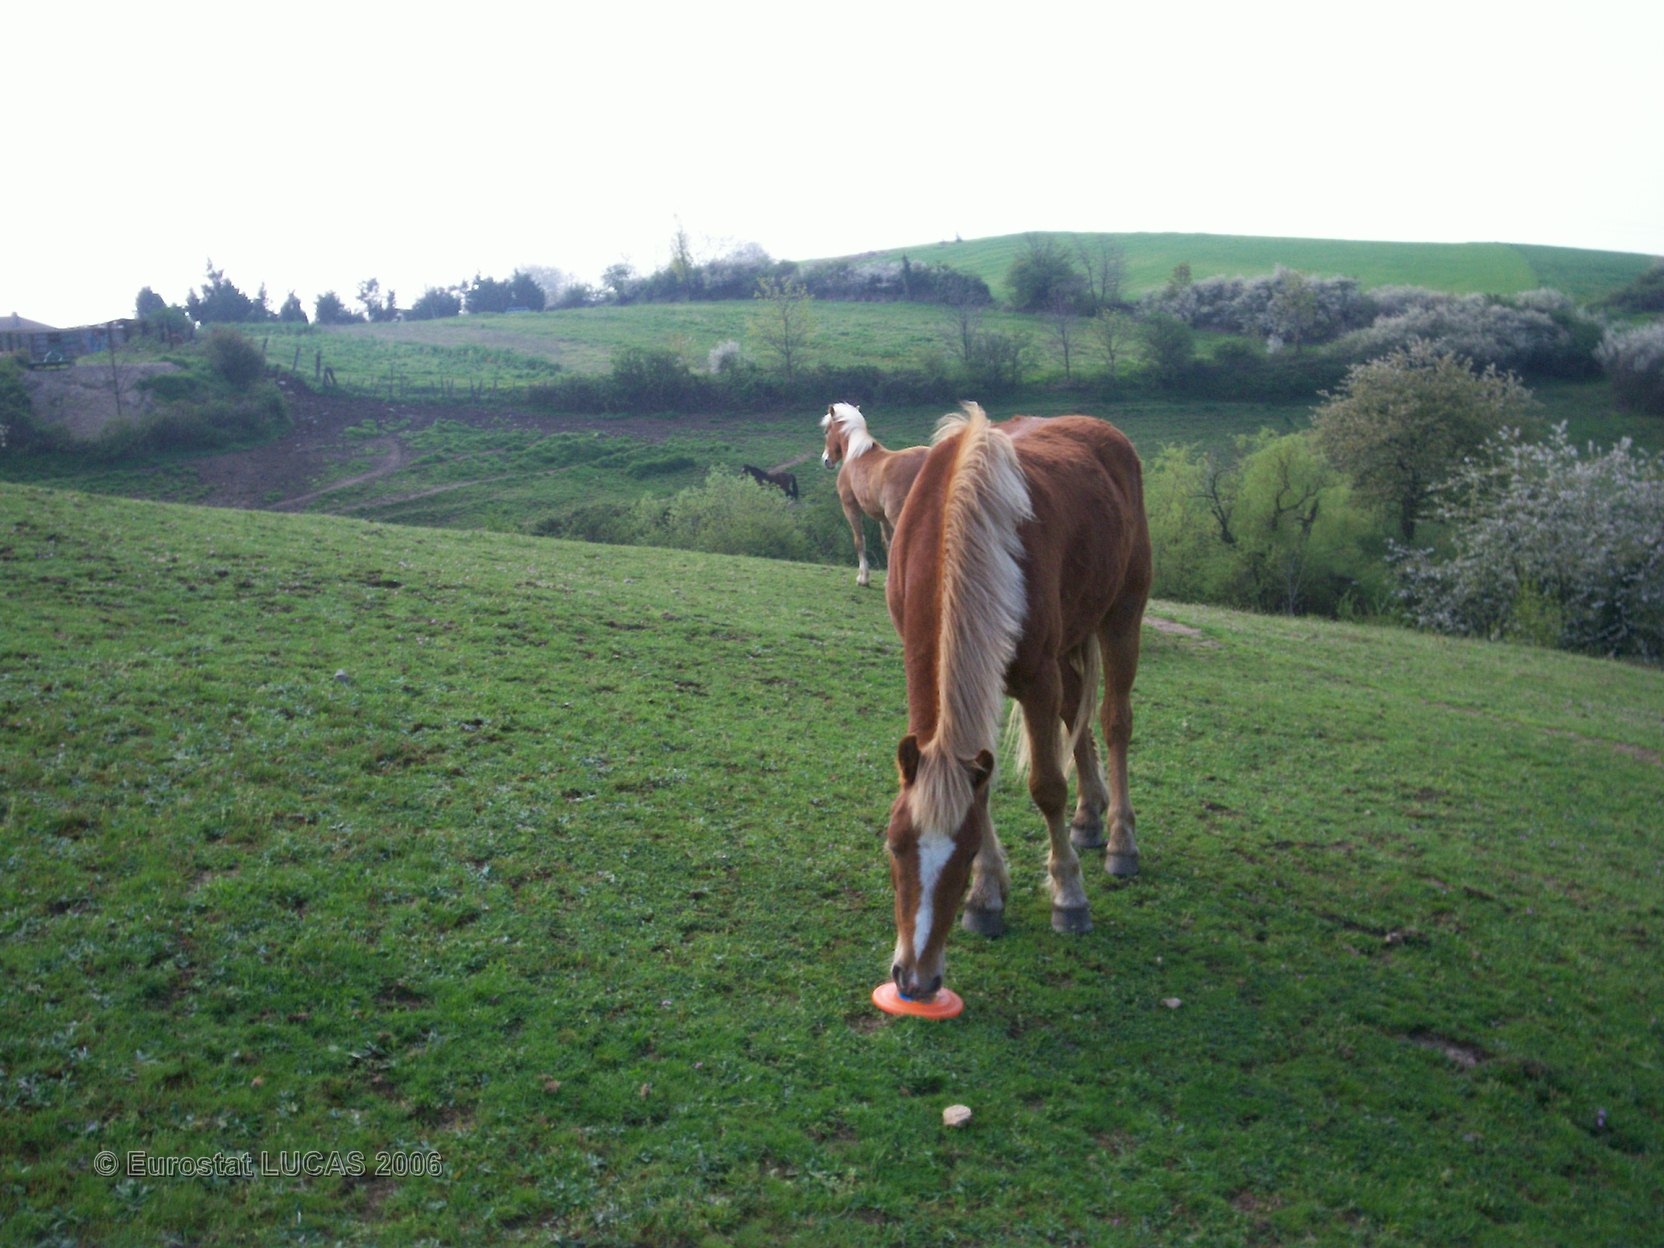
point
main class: Grassland
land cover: Grassland with sparse tree/shrub cover
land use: Agriculture (excluding fallow land and kitchen gardens)
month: April
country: FR
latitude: 45.4832
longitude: 4.7715
